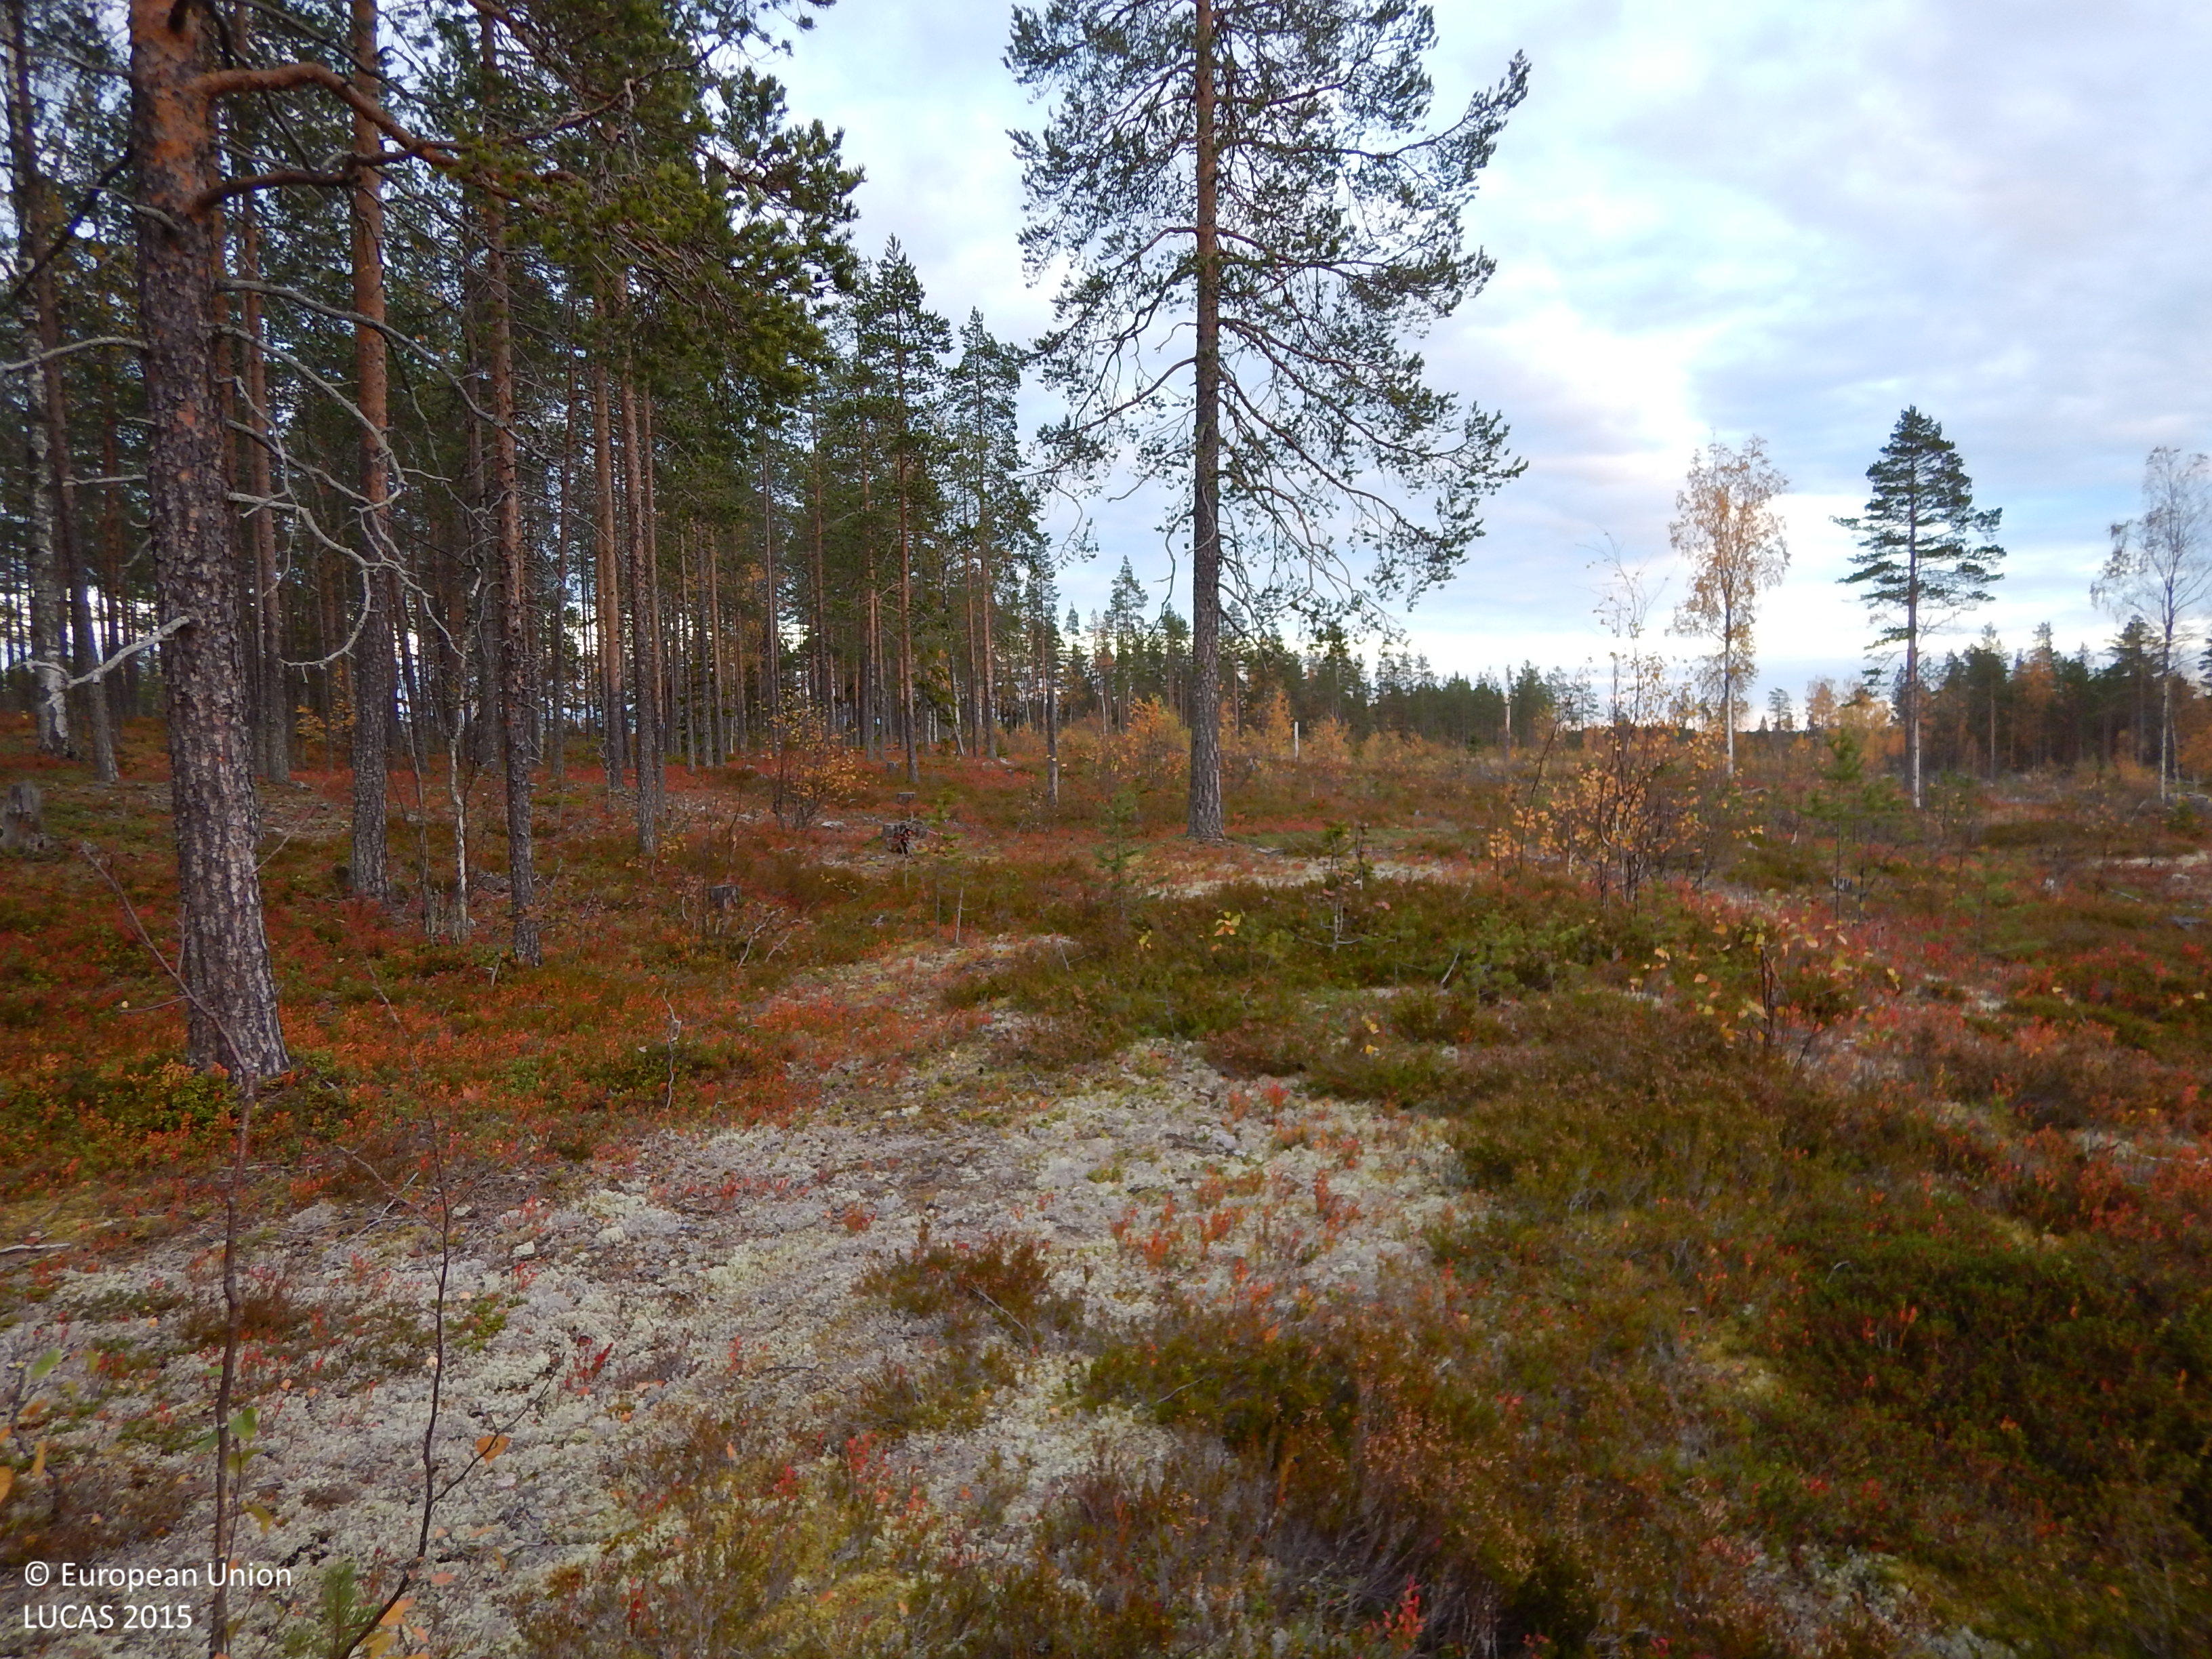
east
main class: Woodland
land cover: Pine dominated coniferous woodland
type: boreal forest
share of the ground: 25 - 50 %
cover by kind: coniferous forest trees 45 %, shrubs 20 %, lichens and mosses 15 %, herbaceous plants 10 %, consolidated bare surface 10 %
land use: Forestry
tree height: > 5 m
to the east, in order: Pine dominated coniferous woodland; Rocks and stones; Pine dominated coniferous woodland; Rocks and stones
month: October
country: SE
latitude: 65.0768
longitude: 20.9701
